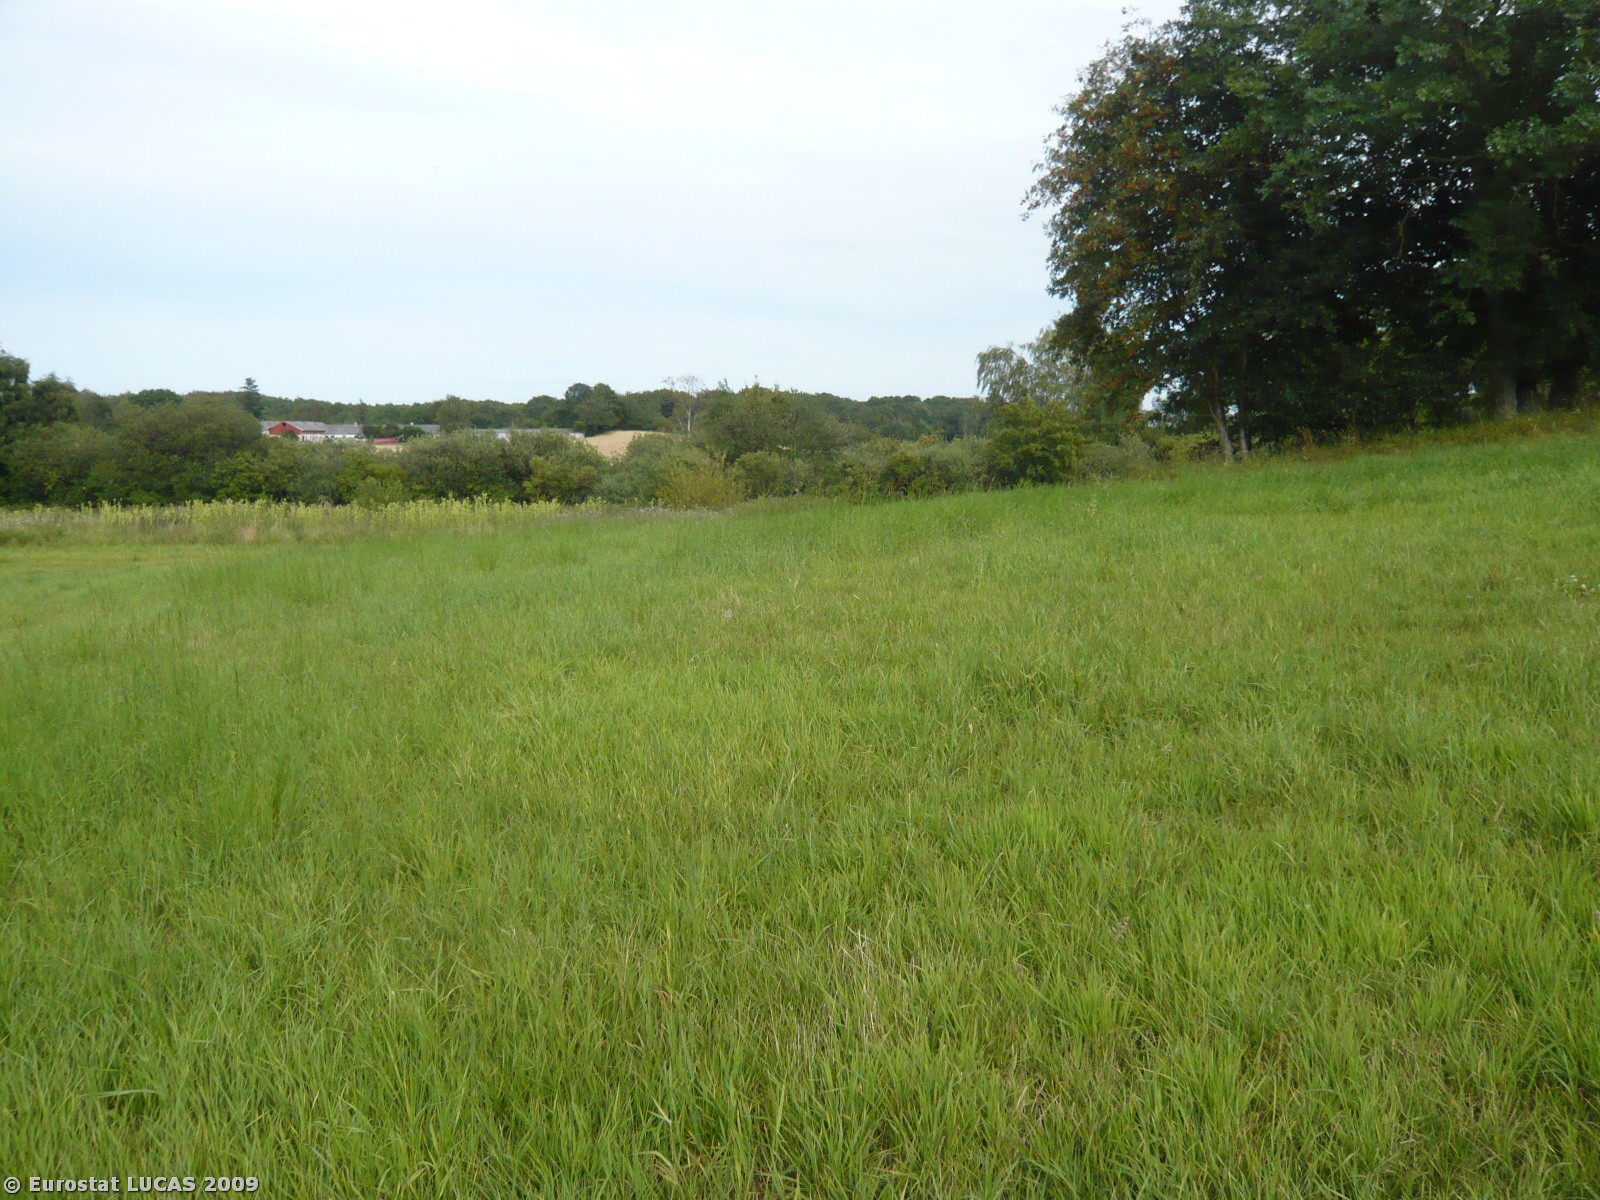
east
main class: Grassland
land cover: Grassland without tree/shrub cover
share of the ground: > 75 %
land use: Agriculture (excluding fallow land and kitchen gardens)
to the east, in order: Grassland without tree/shrub cover; Broadleaved woodland; Tracks; Grassland without tree/shrub cover; Tracks; Grassland without tree/shrub cover; Tracks; Grassland without tree/shrub cover
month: August
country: DK
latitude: 56.0582
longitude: 12.3584
